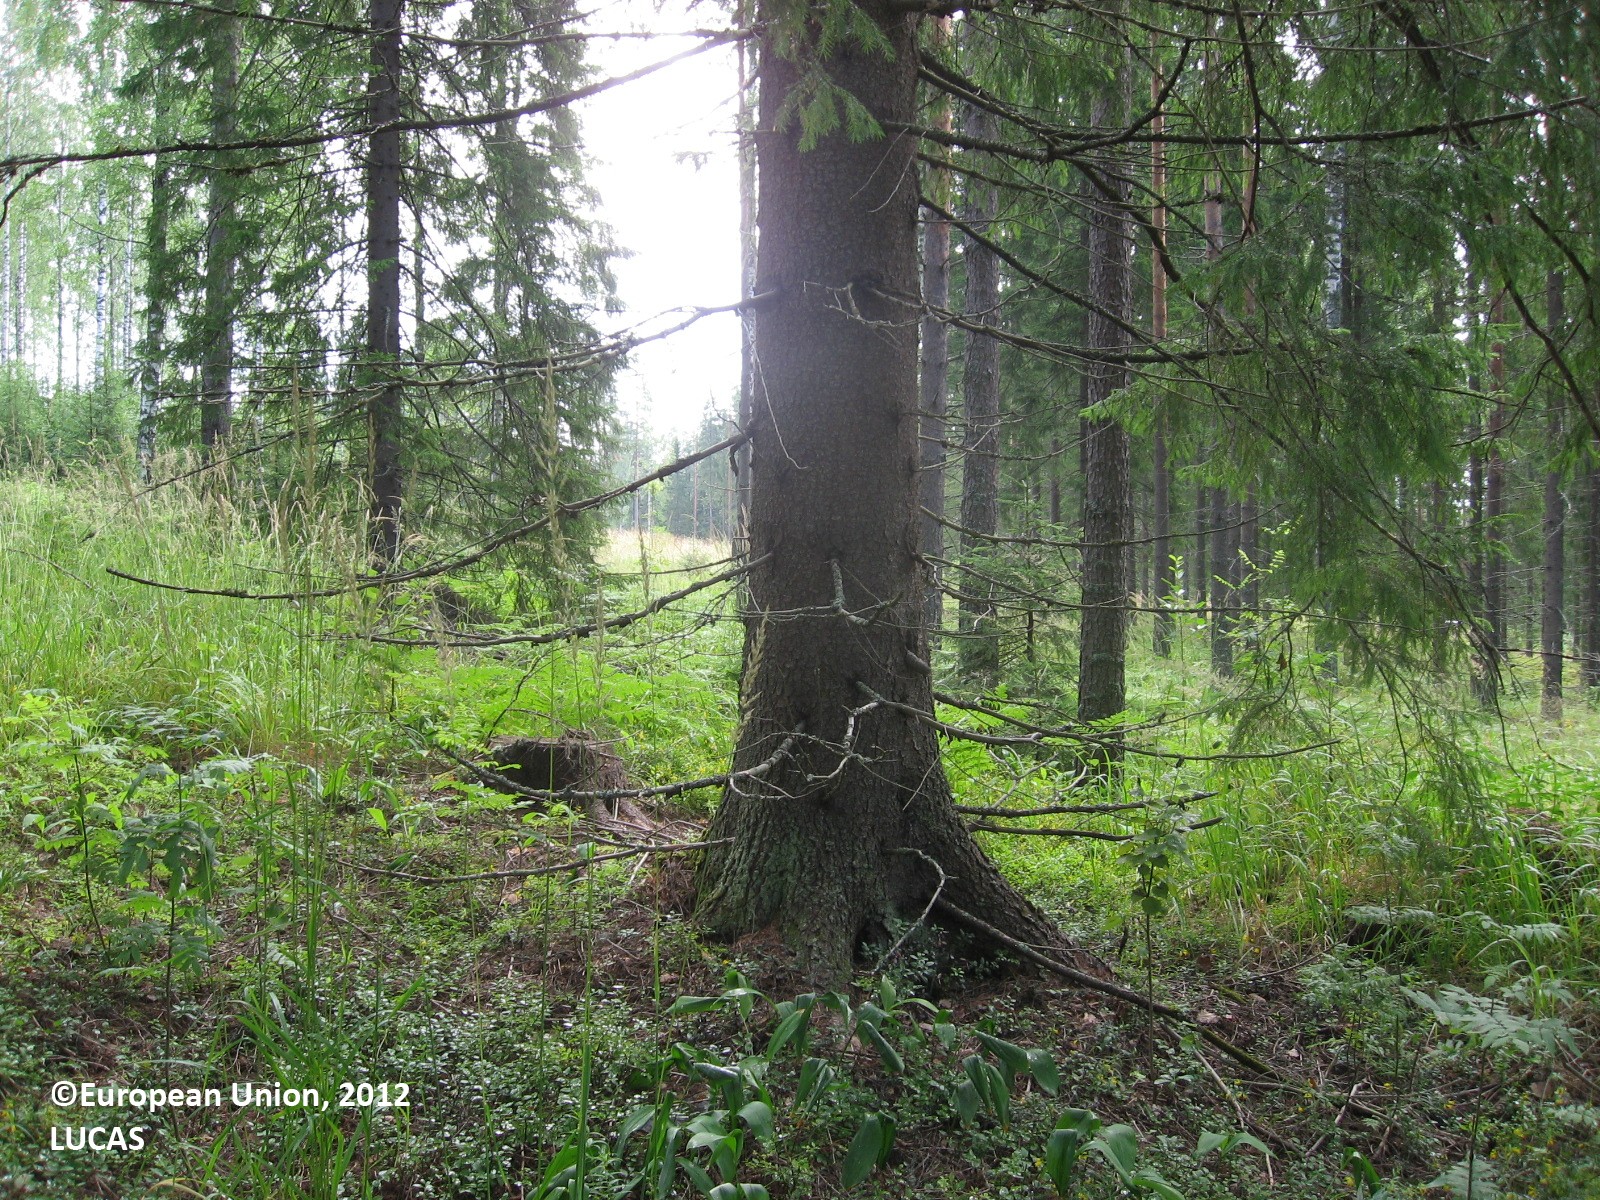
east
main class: Woodland
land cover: Spruce dominated coniferous woodland
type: boreal forest
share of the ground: 25 - 50 %
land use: Forestry
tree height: > 5 m
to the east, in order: Spruce dominated coniferous woodland; Spontaneously vegetated surfaces; Paved roads, cycling and walking lanes; Spontaneously vegetated surfaces; Other bare soil; Pine dominated coniferous woodland; Other bare soil; Broadleaved woodland; Ditches and canals; Broadleaved woodland
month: July
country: FI
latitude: 61.2447
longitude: 26.5301
